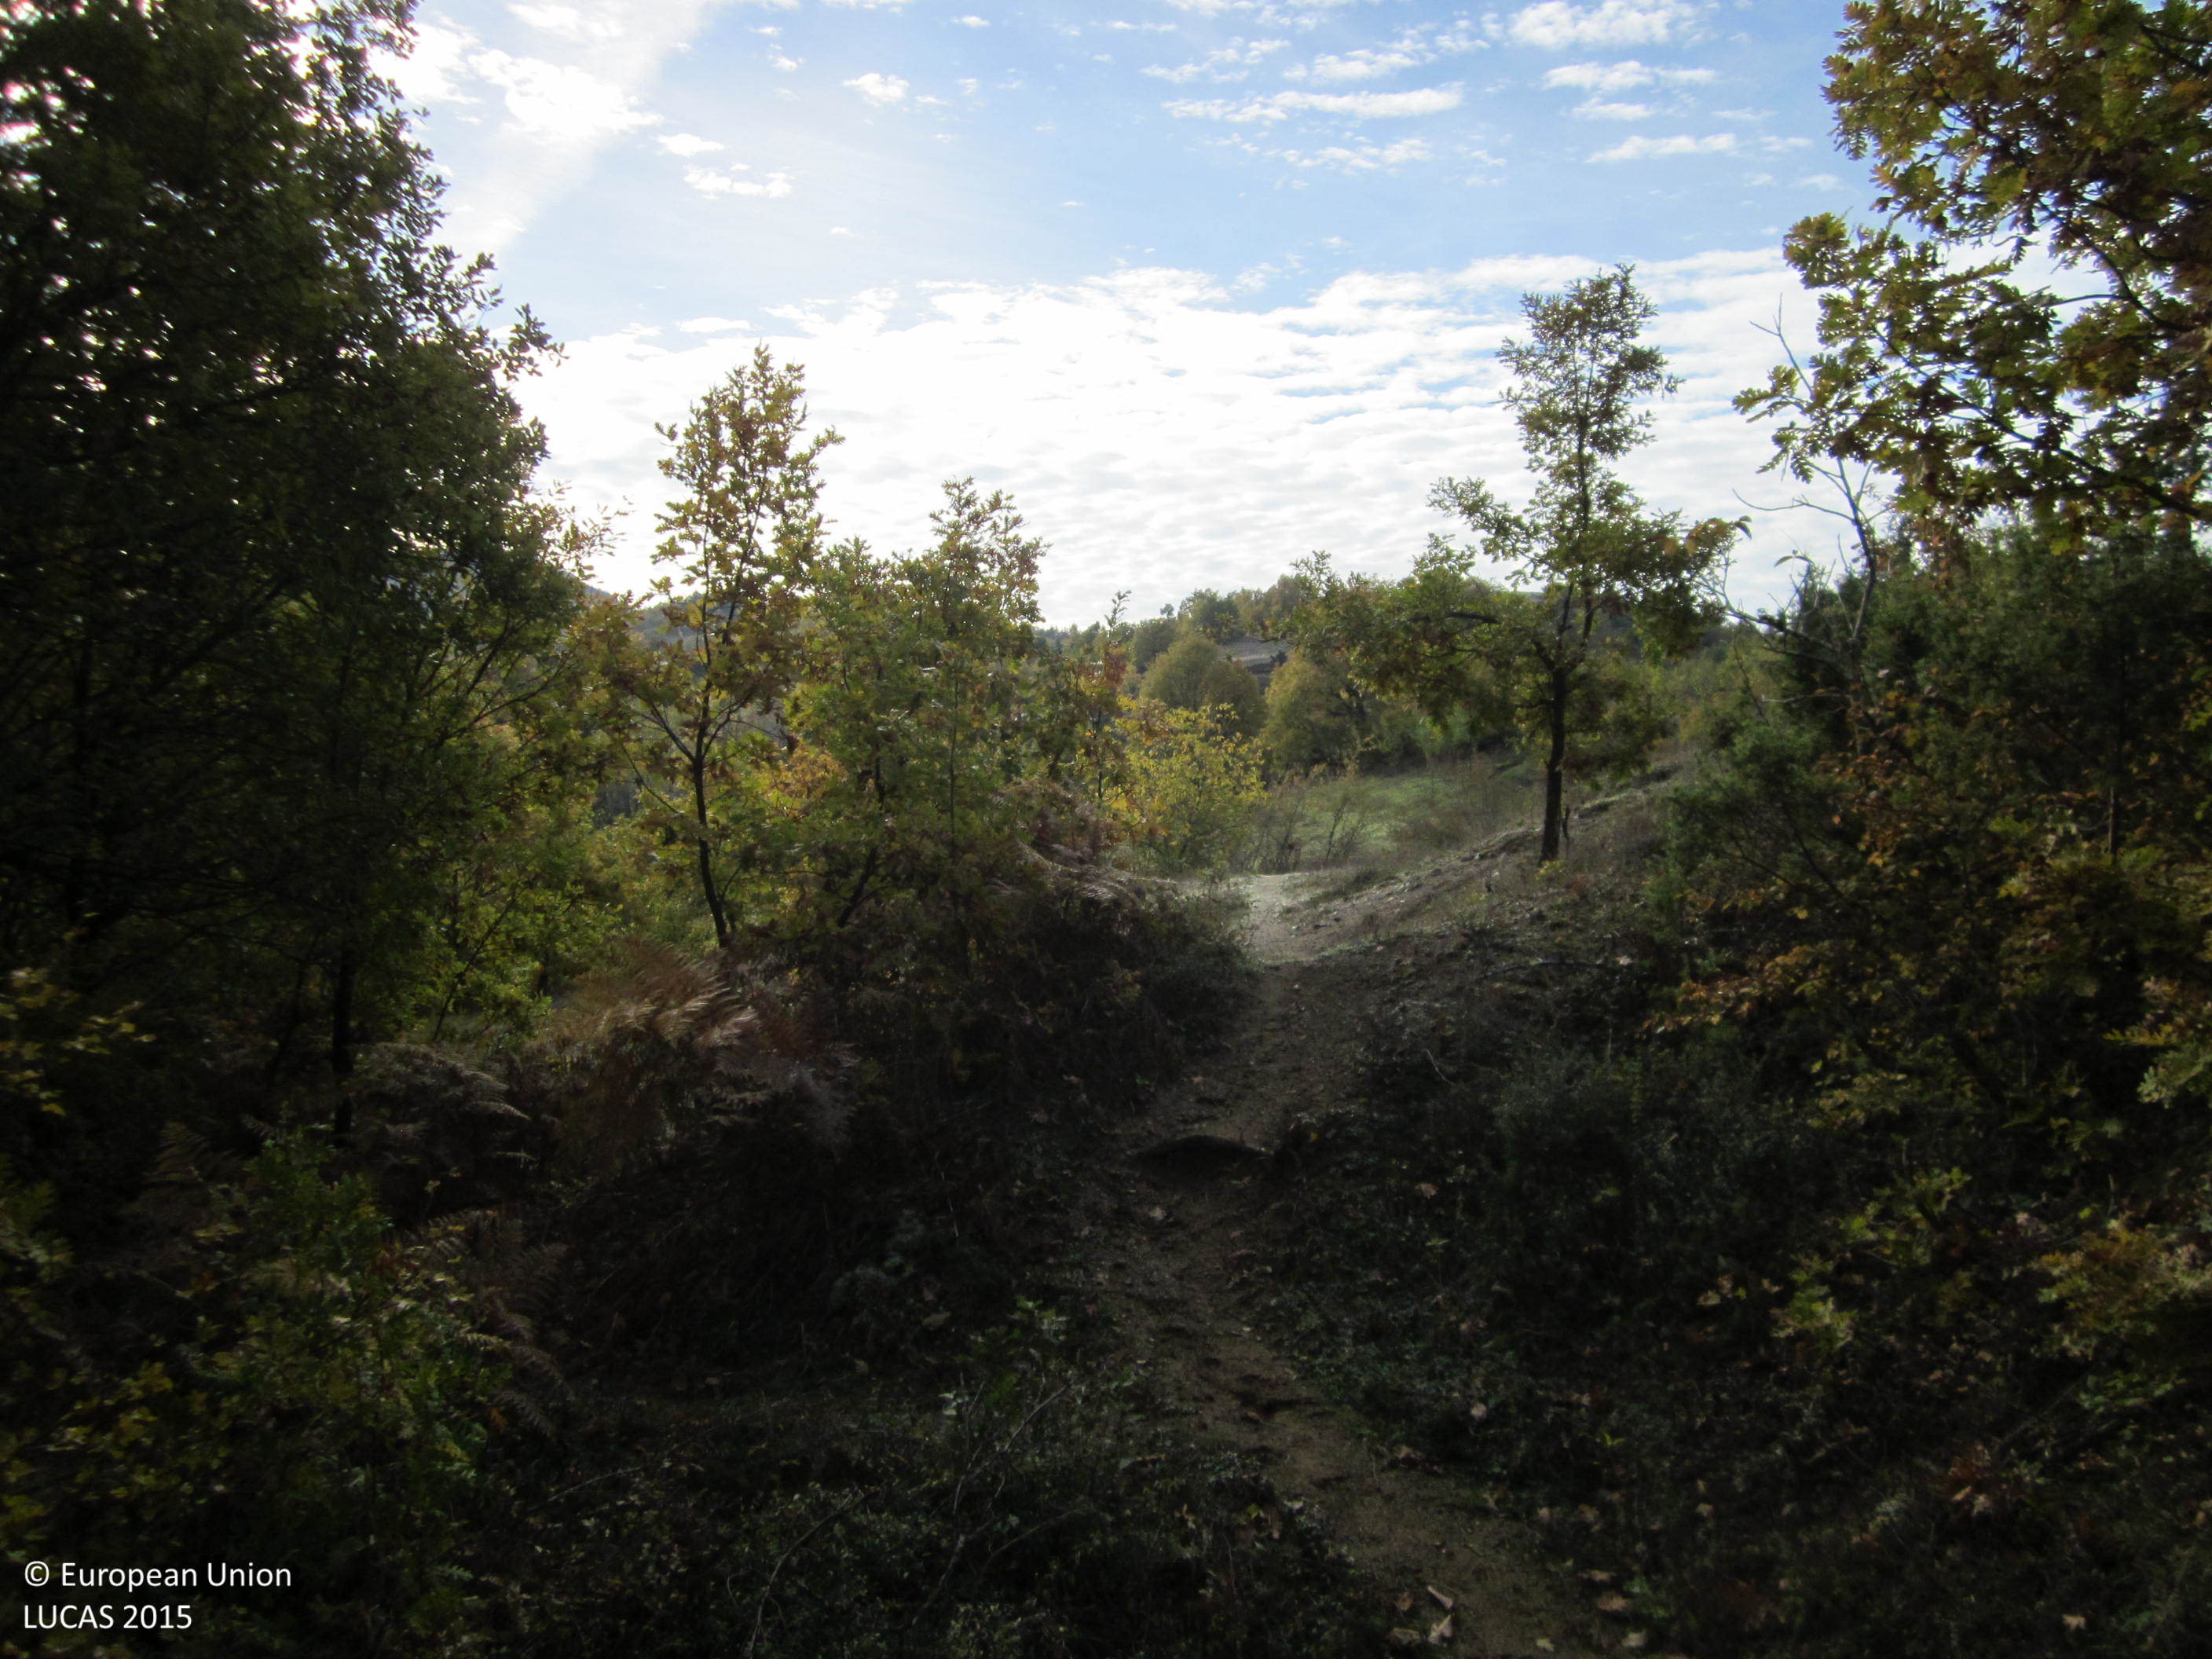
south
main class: Woodland
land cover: Broadleaved woodland
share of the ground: 50 - 75 %
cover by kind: broadleaved forest trees 70 %, shrubs 15 %, herbaceous plants 15 %
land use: Forestry
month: November
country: BG
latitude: 41.3504
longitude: 25.6804
